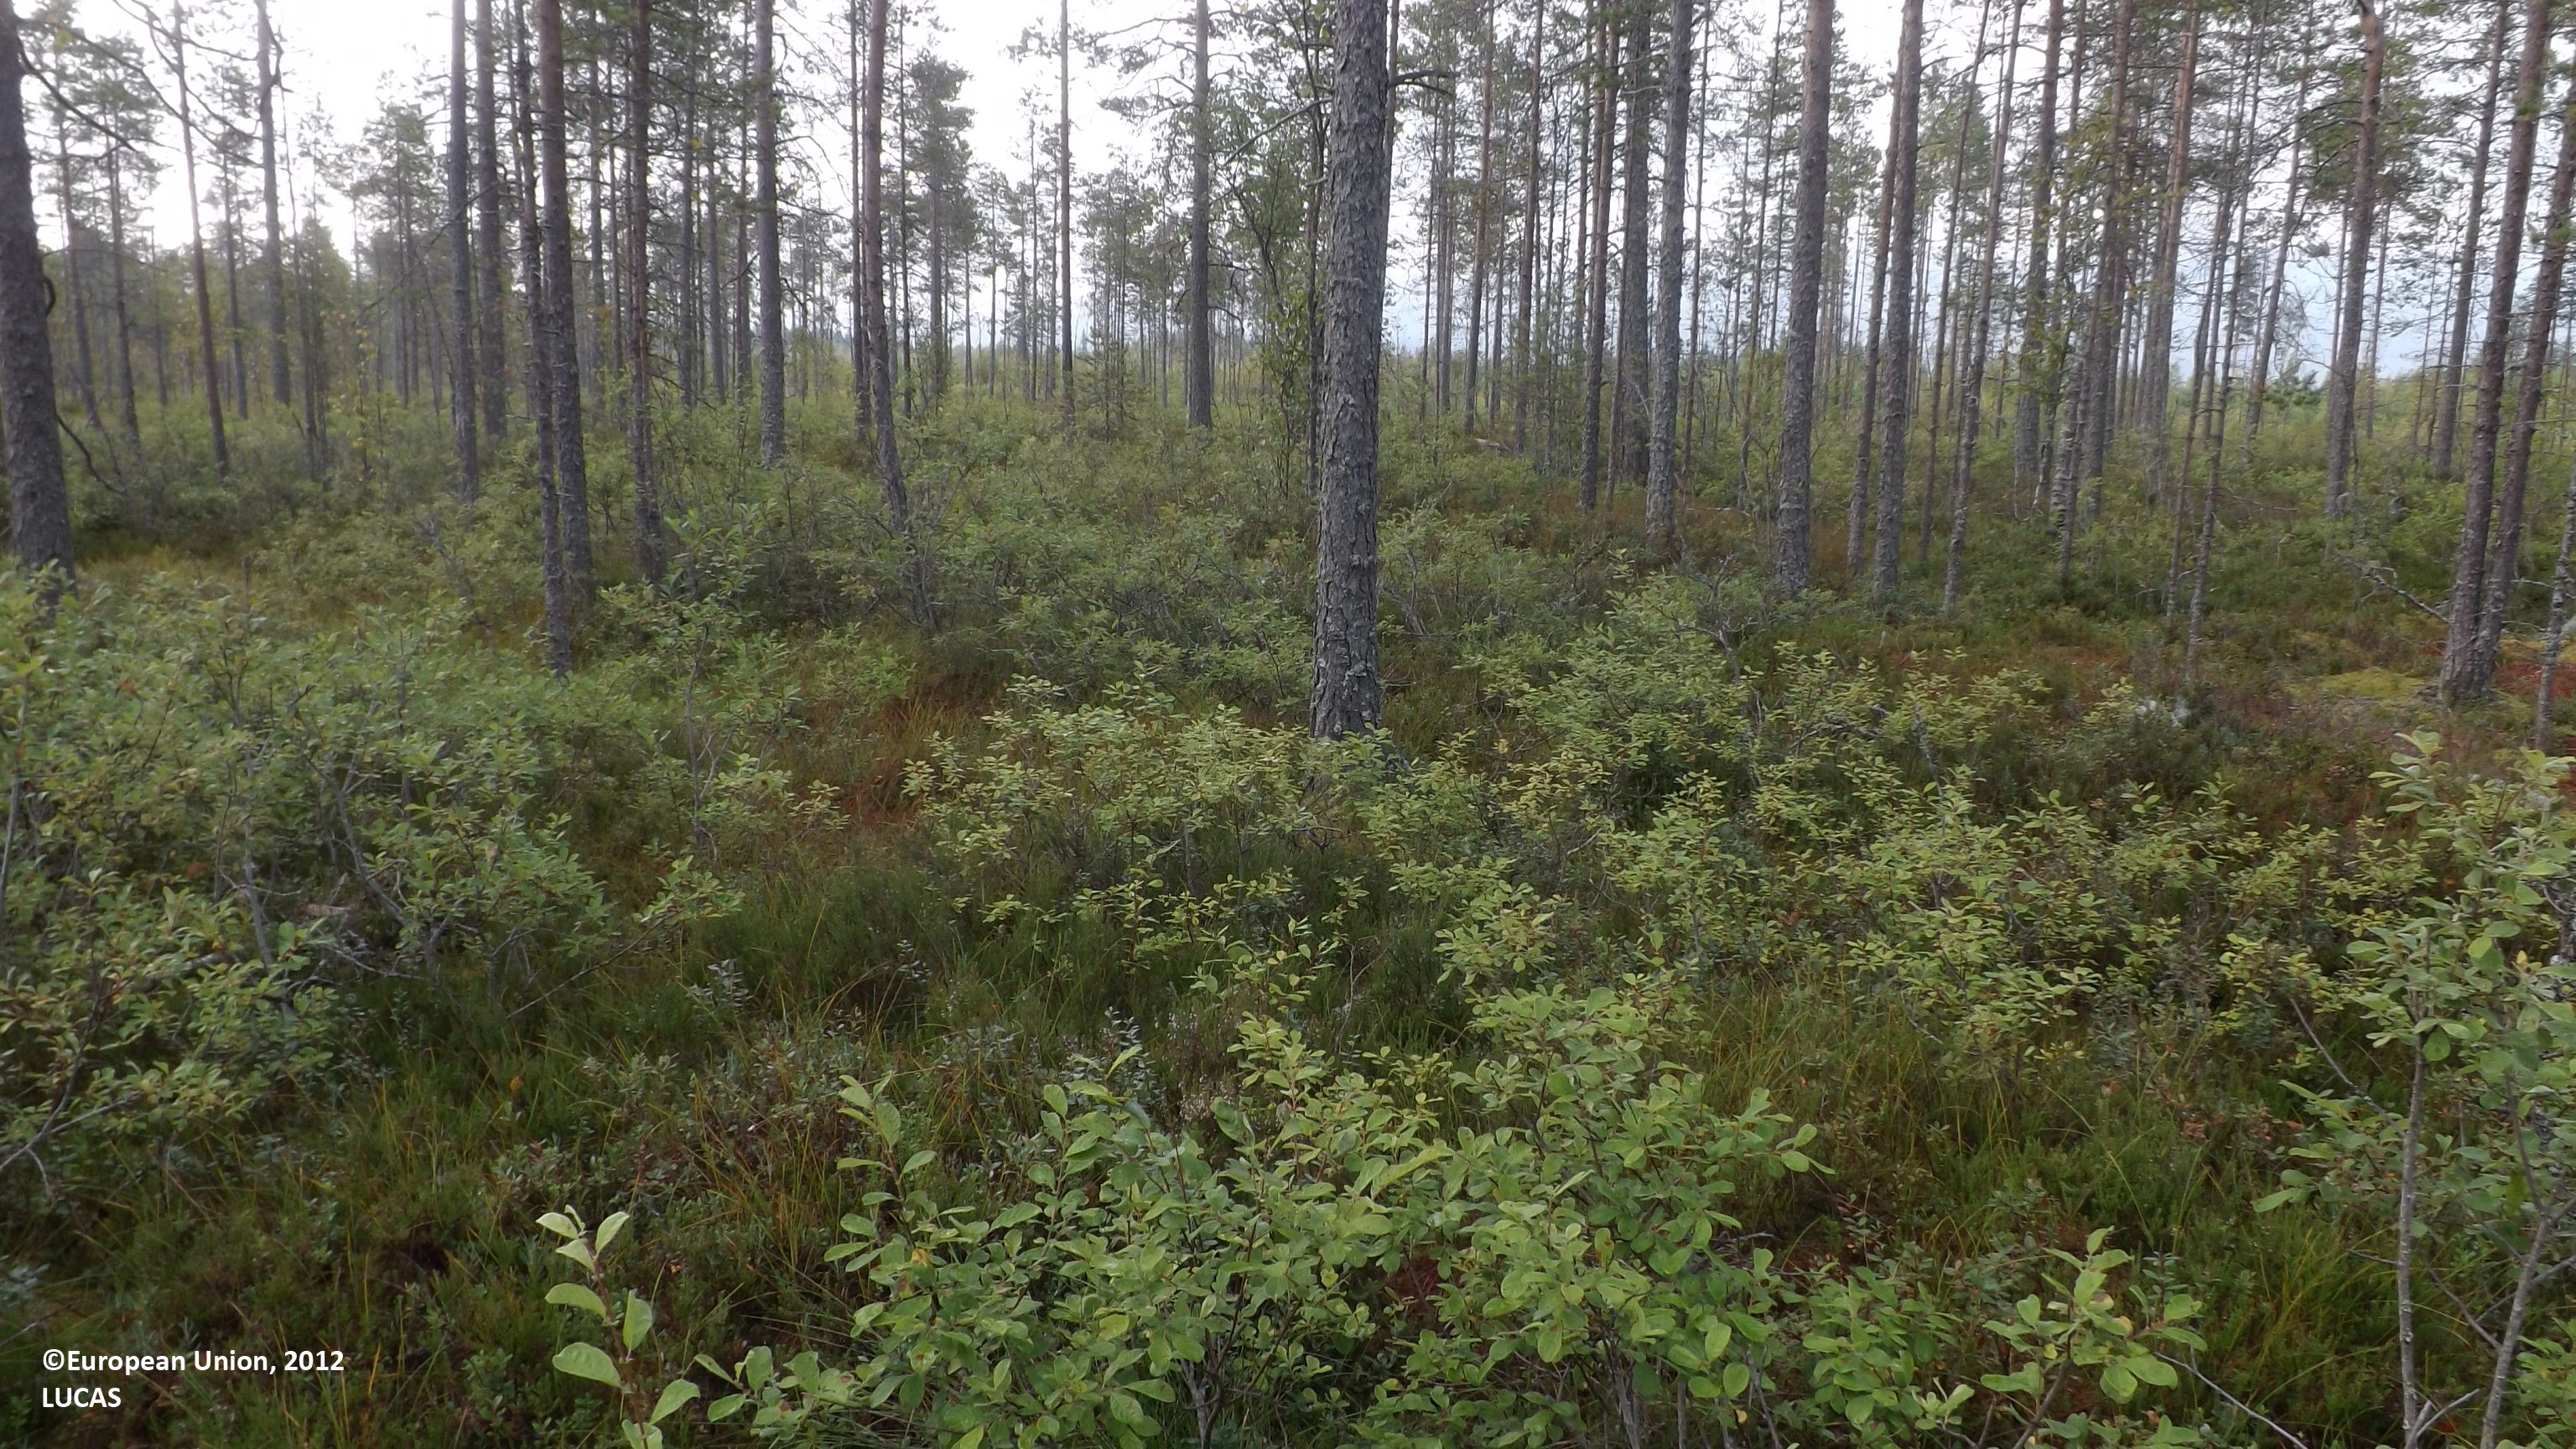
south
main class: Woodland
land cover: Pine dominated coniferous woodland
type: mire and swamp forests
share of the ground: 10 - 25 %
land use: Forestry
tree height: > 5 m
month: August
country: FI
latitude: 63.8087
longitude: 24.0187
